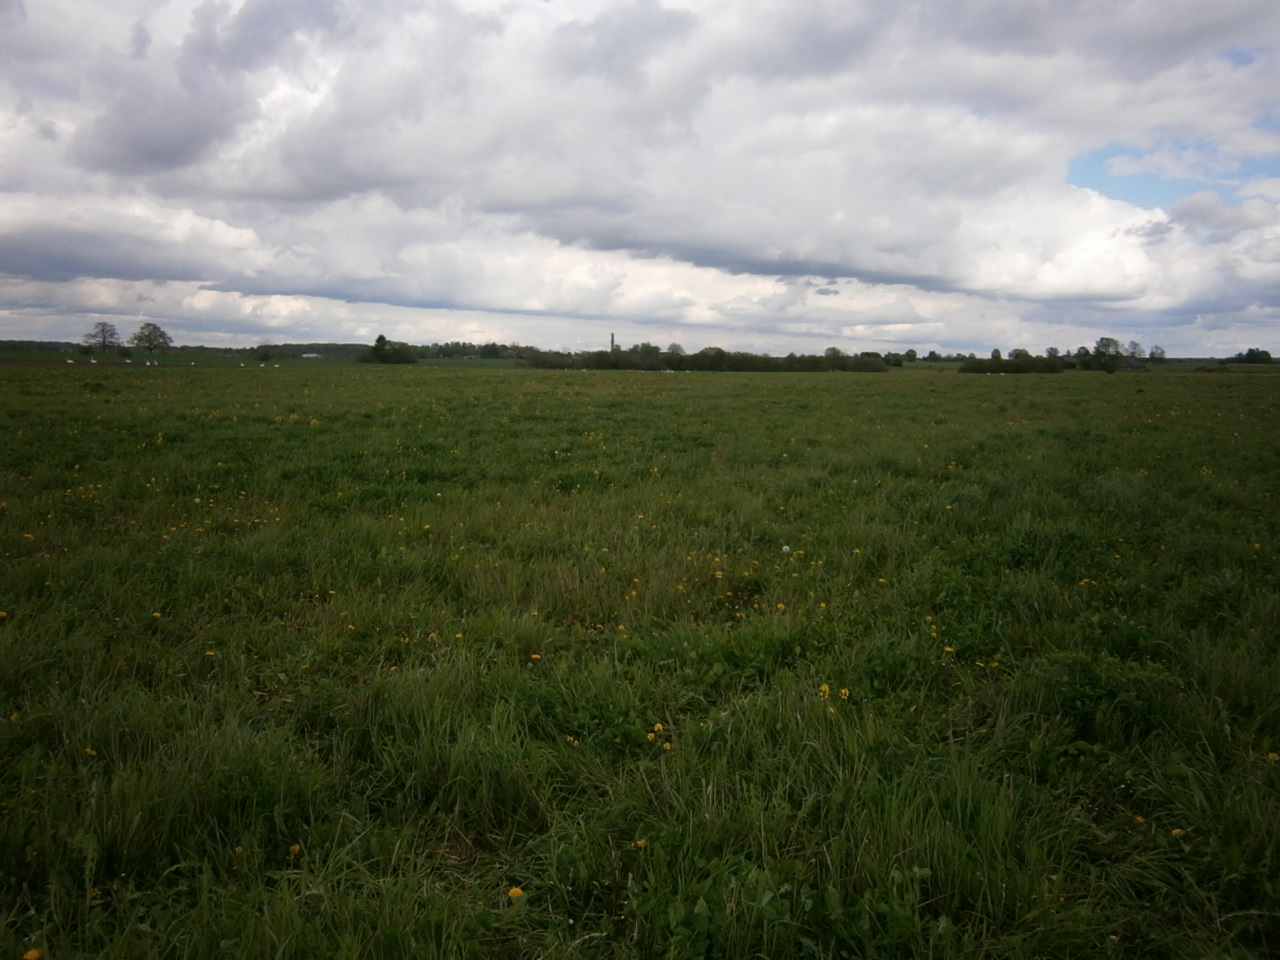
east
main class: Grassland
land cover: Grassland without tree/shrub cover
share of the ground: > 75 %
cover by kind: herbaceous plants 100 %
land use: Agriculture (excluding fallow land and kitchen gardens)
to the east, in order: Grassland without tree/shrub cover; Common wheat
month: May
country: LV
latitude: 56.6433
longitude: 22.3662
